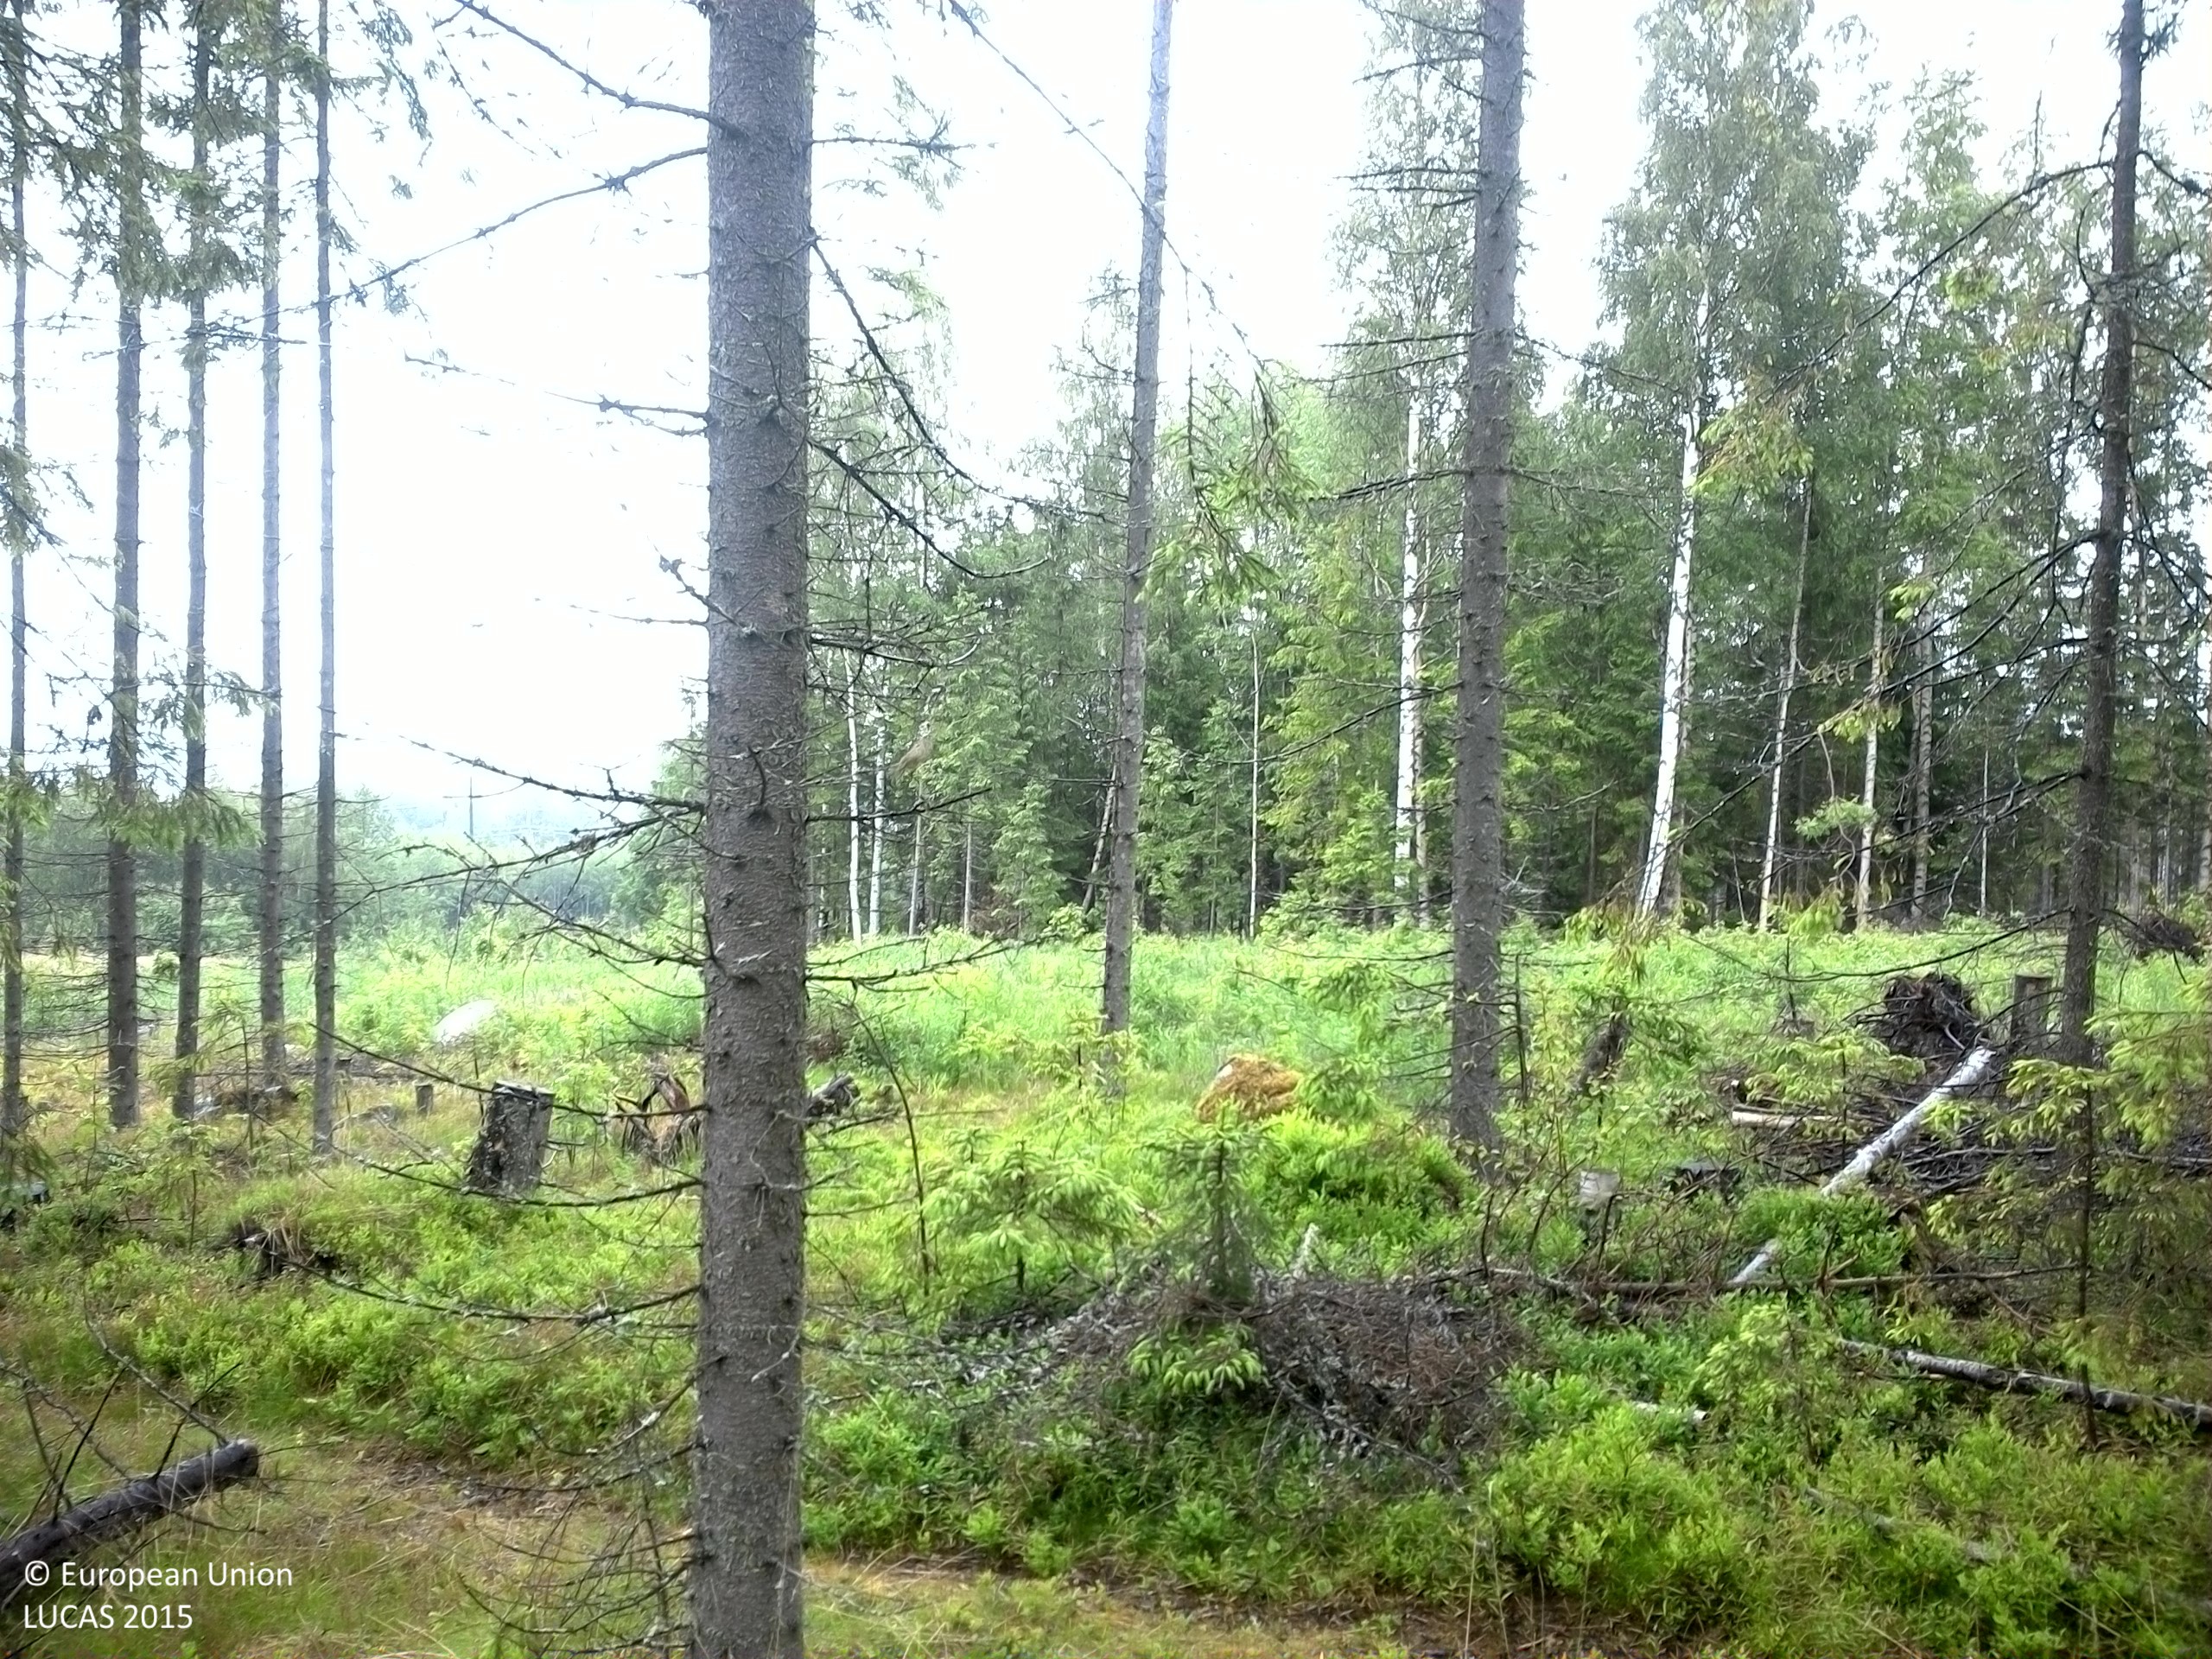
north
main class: Woodland
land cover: Spruce dominated mixed woodland
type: boreal forest
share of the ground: > 75 %
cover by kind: coniferous forest trees 60 %, broadleaved forest trees 20 %, shrubs 15 %, herbaceous plants 5 %
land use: Forestry
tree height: > 5 m
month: June
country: SE
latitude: 62.7669
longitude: 17.9124
